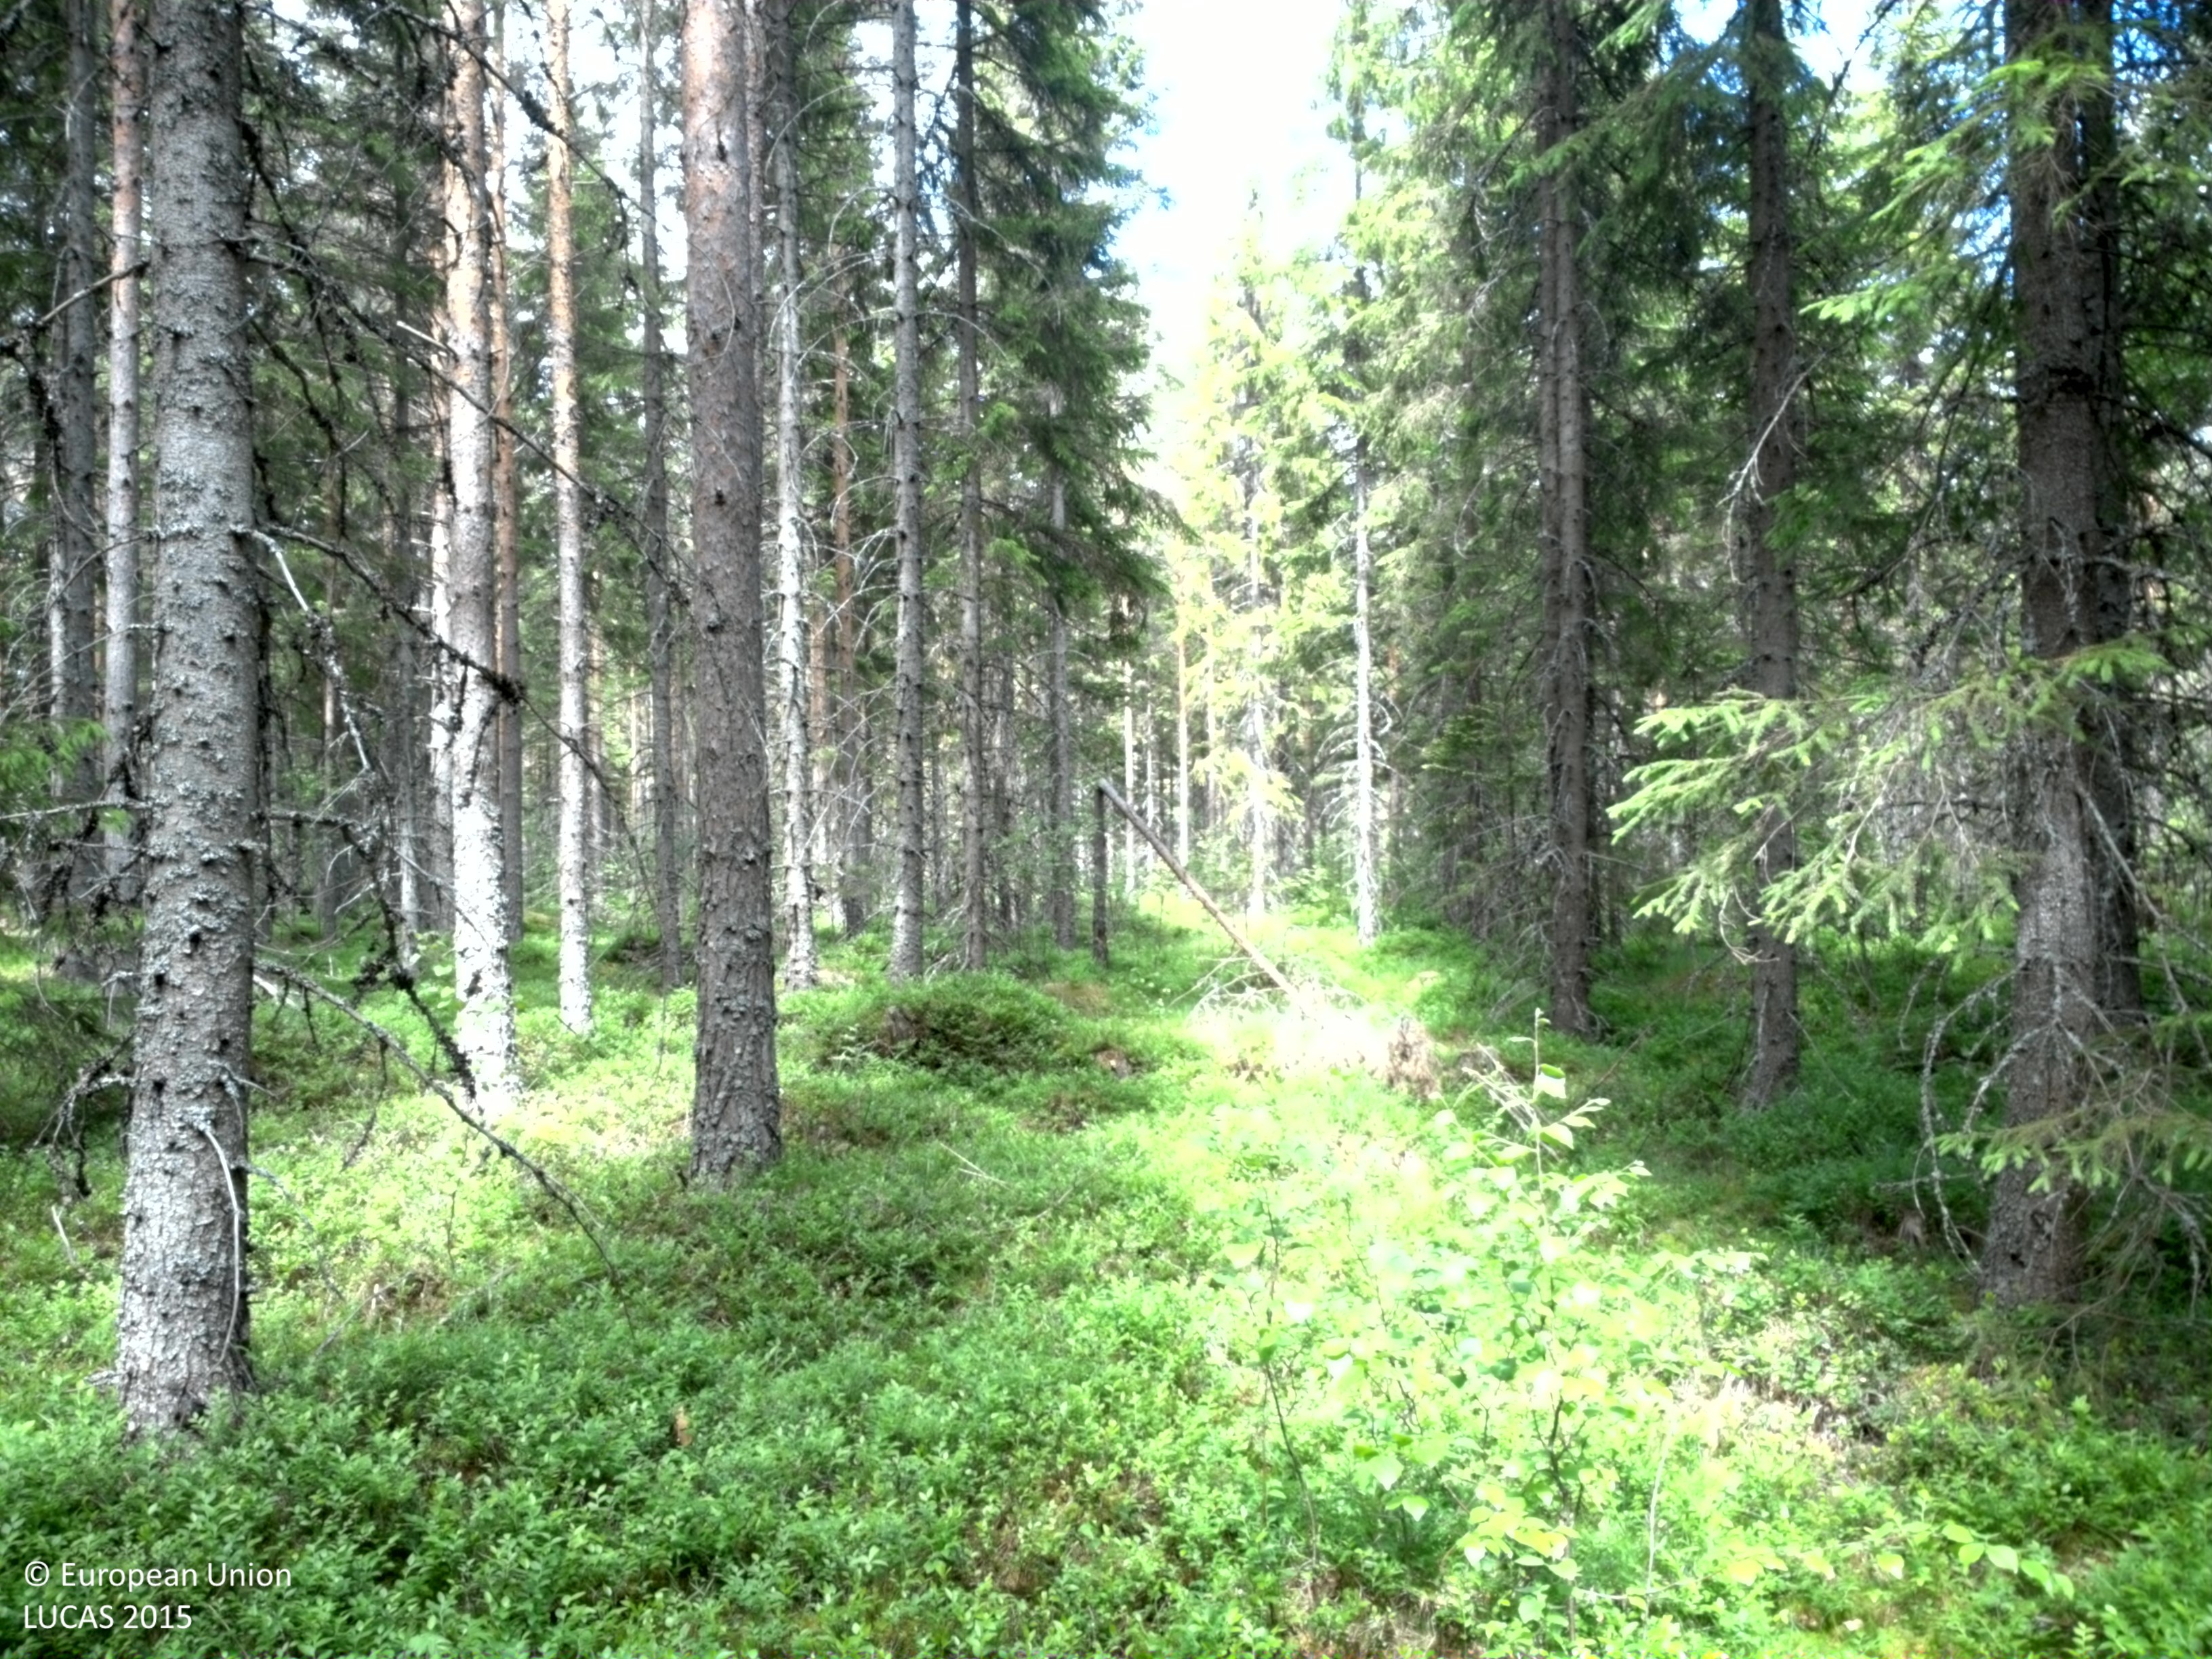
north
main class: Woodland
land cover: Spruce dominated coniferous woodland
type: boreal forest
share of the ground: 25 - 50 %
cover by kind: coniferous forest trees 45 %, lichens and mosses 35 %, herbaceous plants 20 %
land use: Forestry
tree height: > 5 m
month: June
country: SE
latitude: 60.2232
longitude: 17.0129
